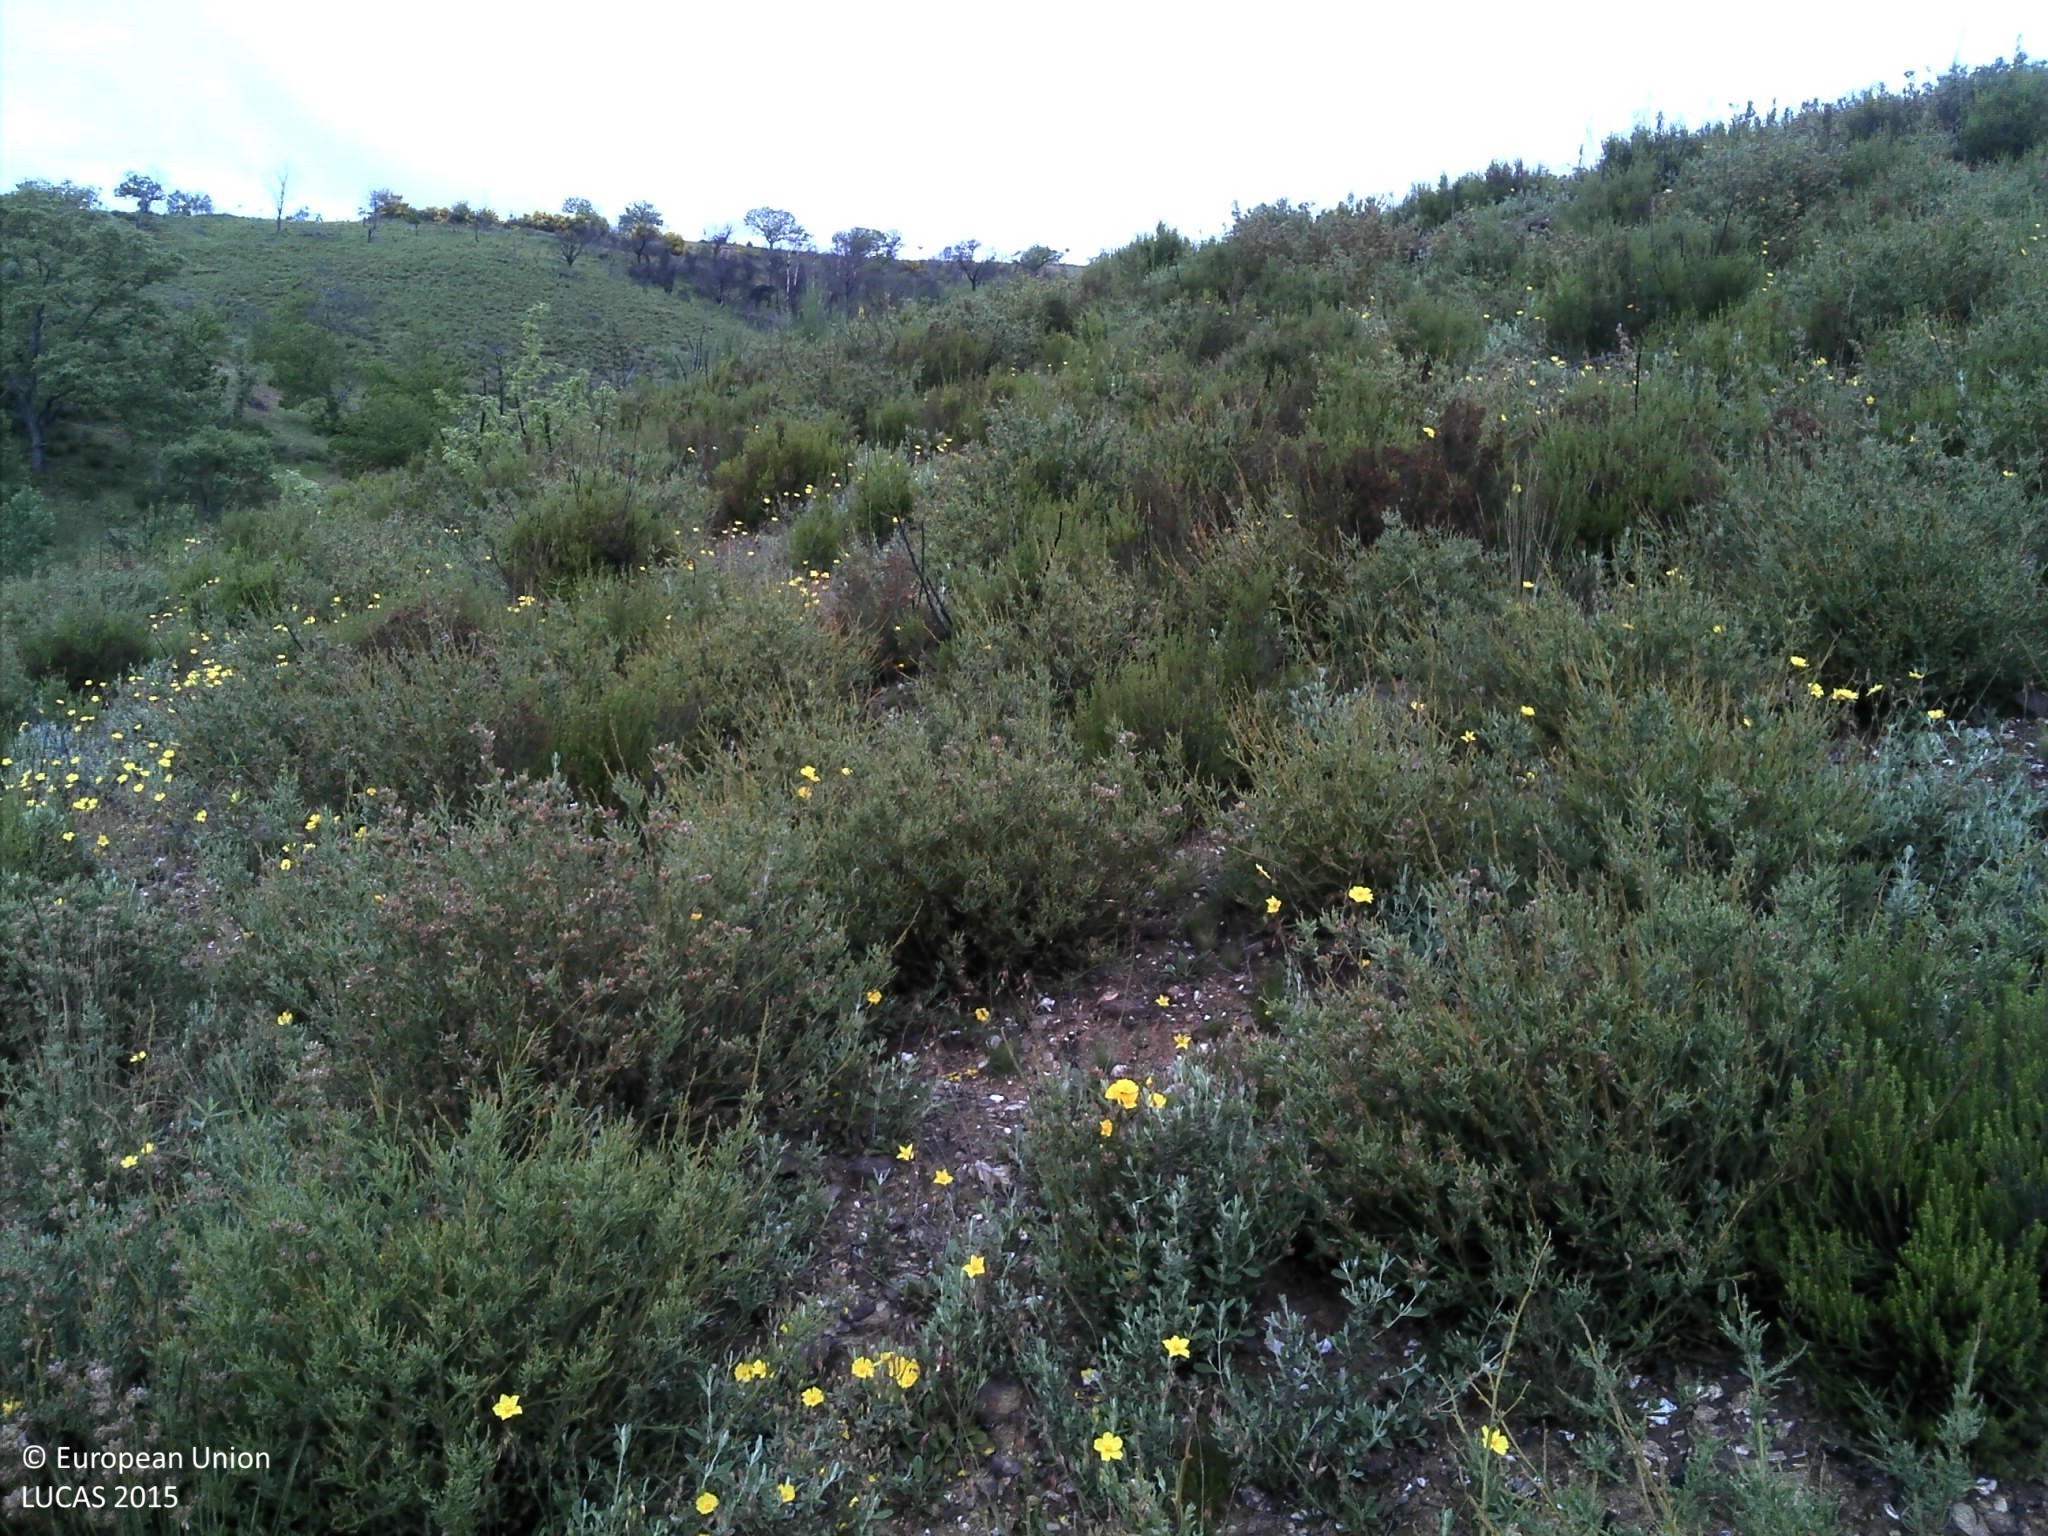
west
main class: Shrubland
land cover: Shrubland with sparse tree cover
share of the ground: > 75 %
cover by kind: shrubs 80 %, unconsolidated bare surface 15 %, broadleaved forest trees 5 %
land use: Forestry
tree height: < 5 m
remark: Burnt area
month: May
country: PT
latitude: 41.7677
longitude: -7.0447
